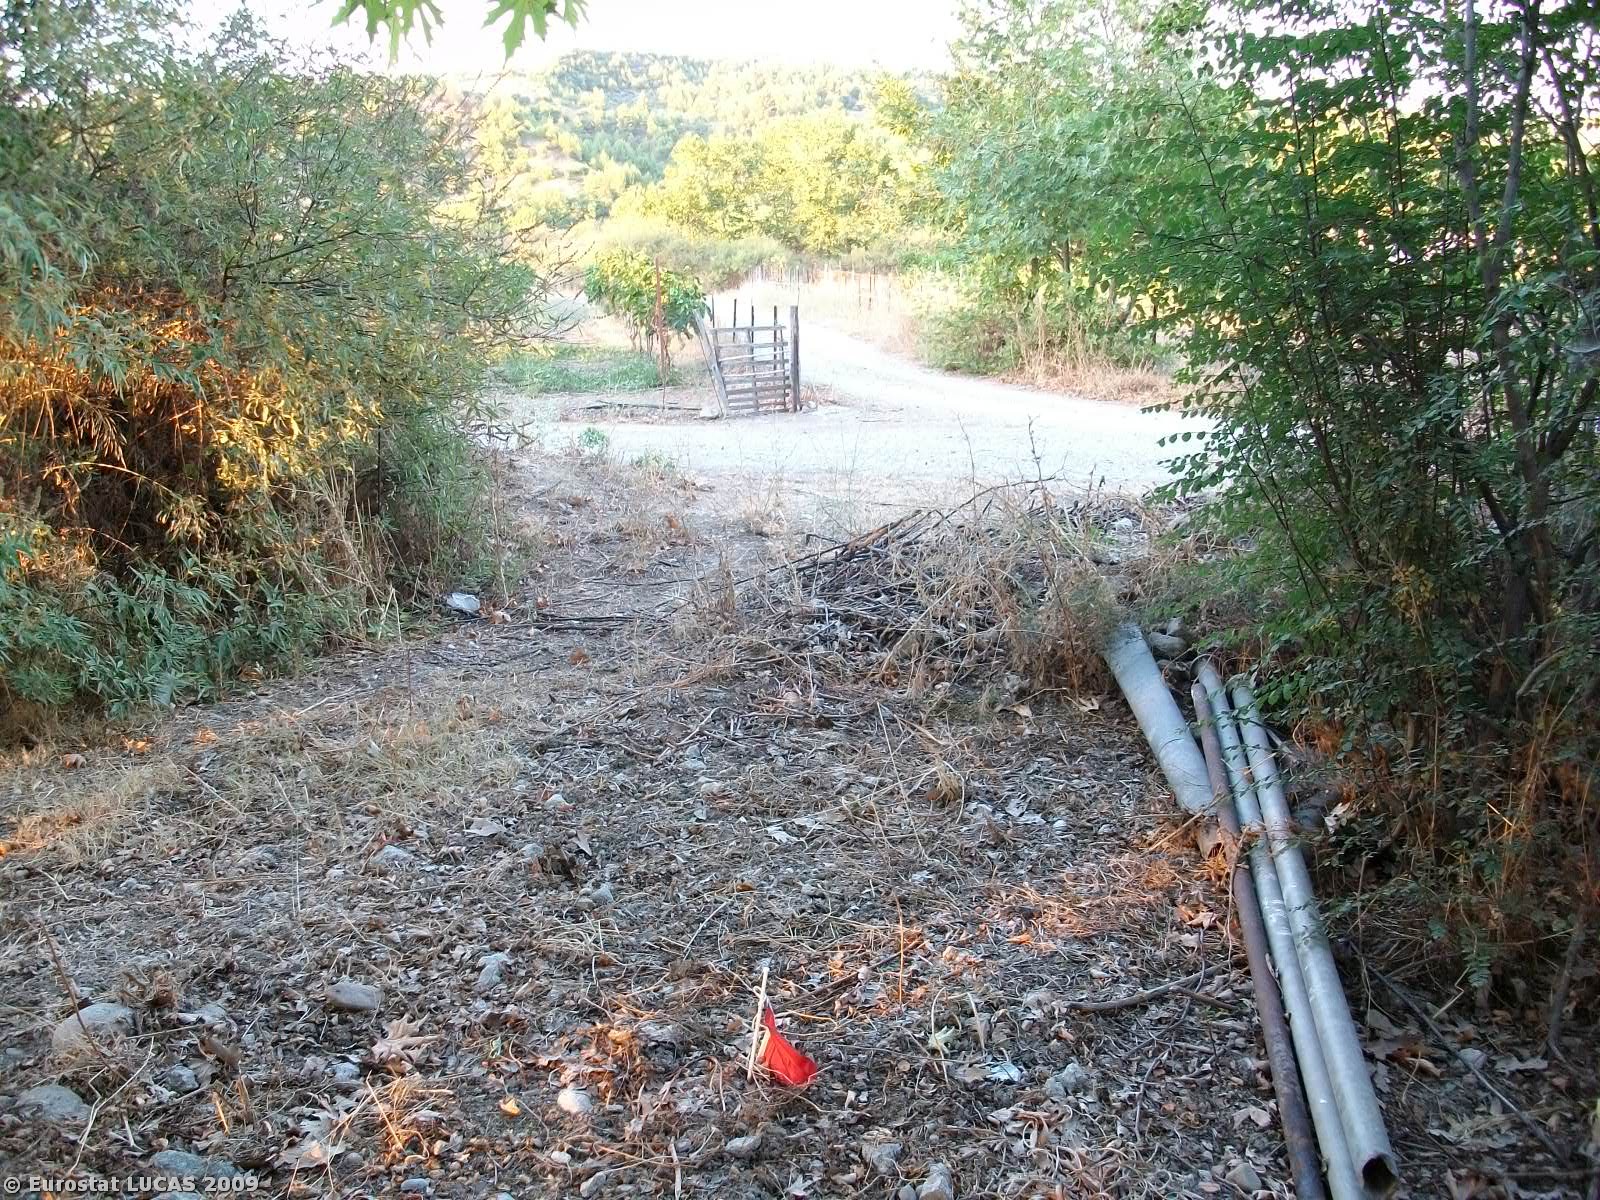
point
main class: Shrubland
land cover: Shrubland with sparse tree cover
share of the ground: 50 - 75 %
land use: Unused
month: August
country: GR
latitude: 38.9352
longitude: 23.1740
